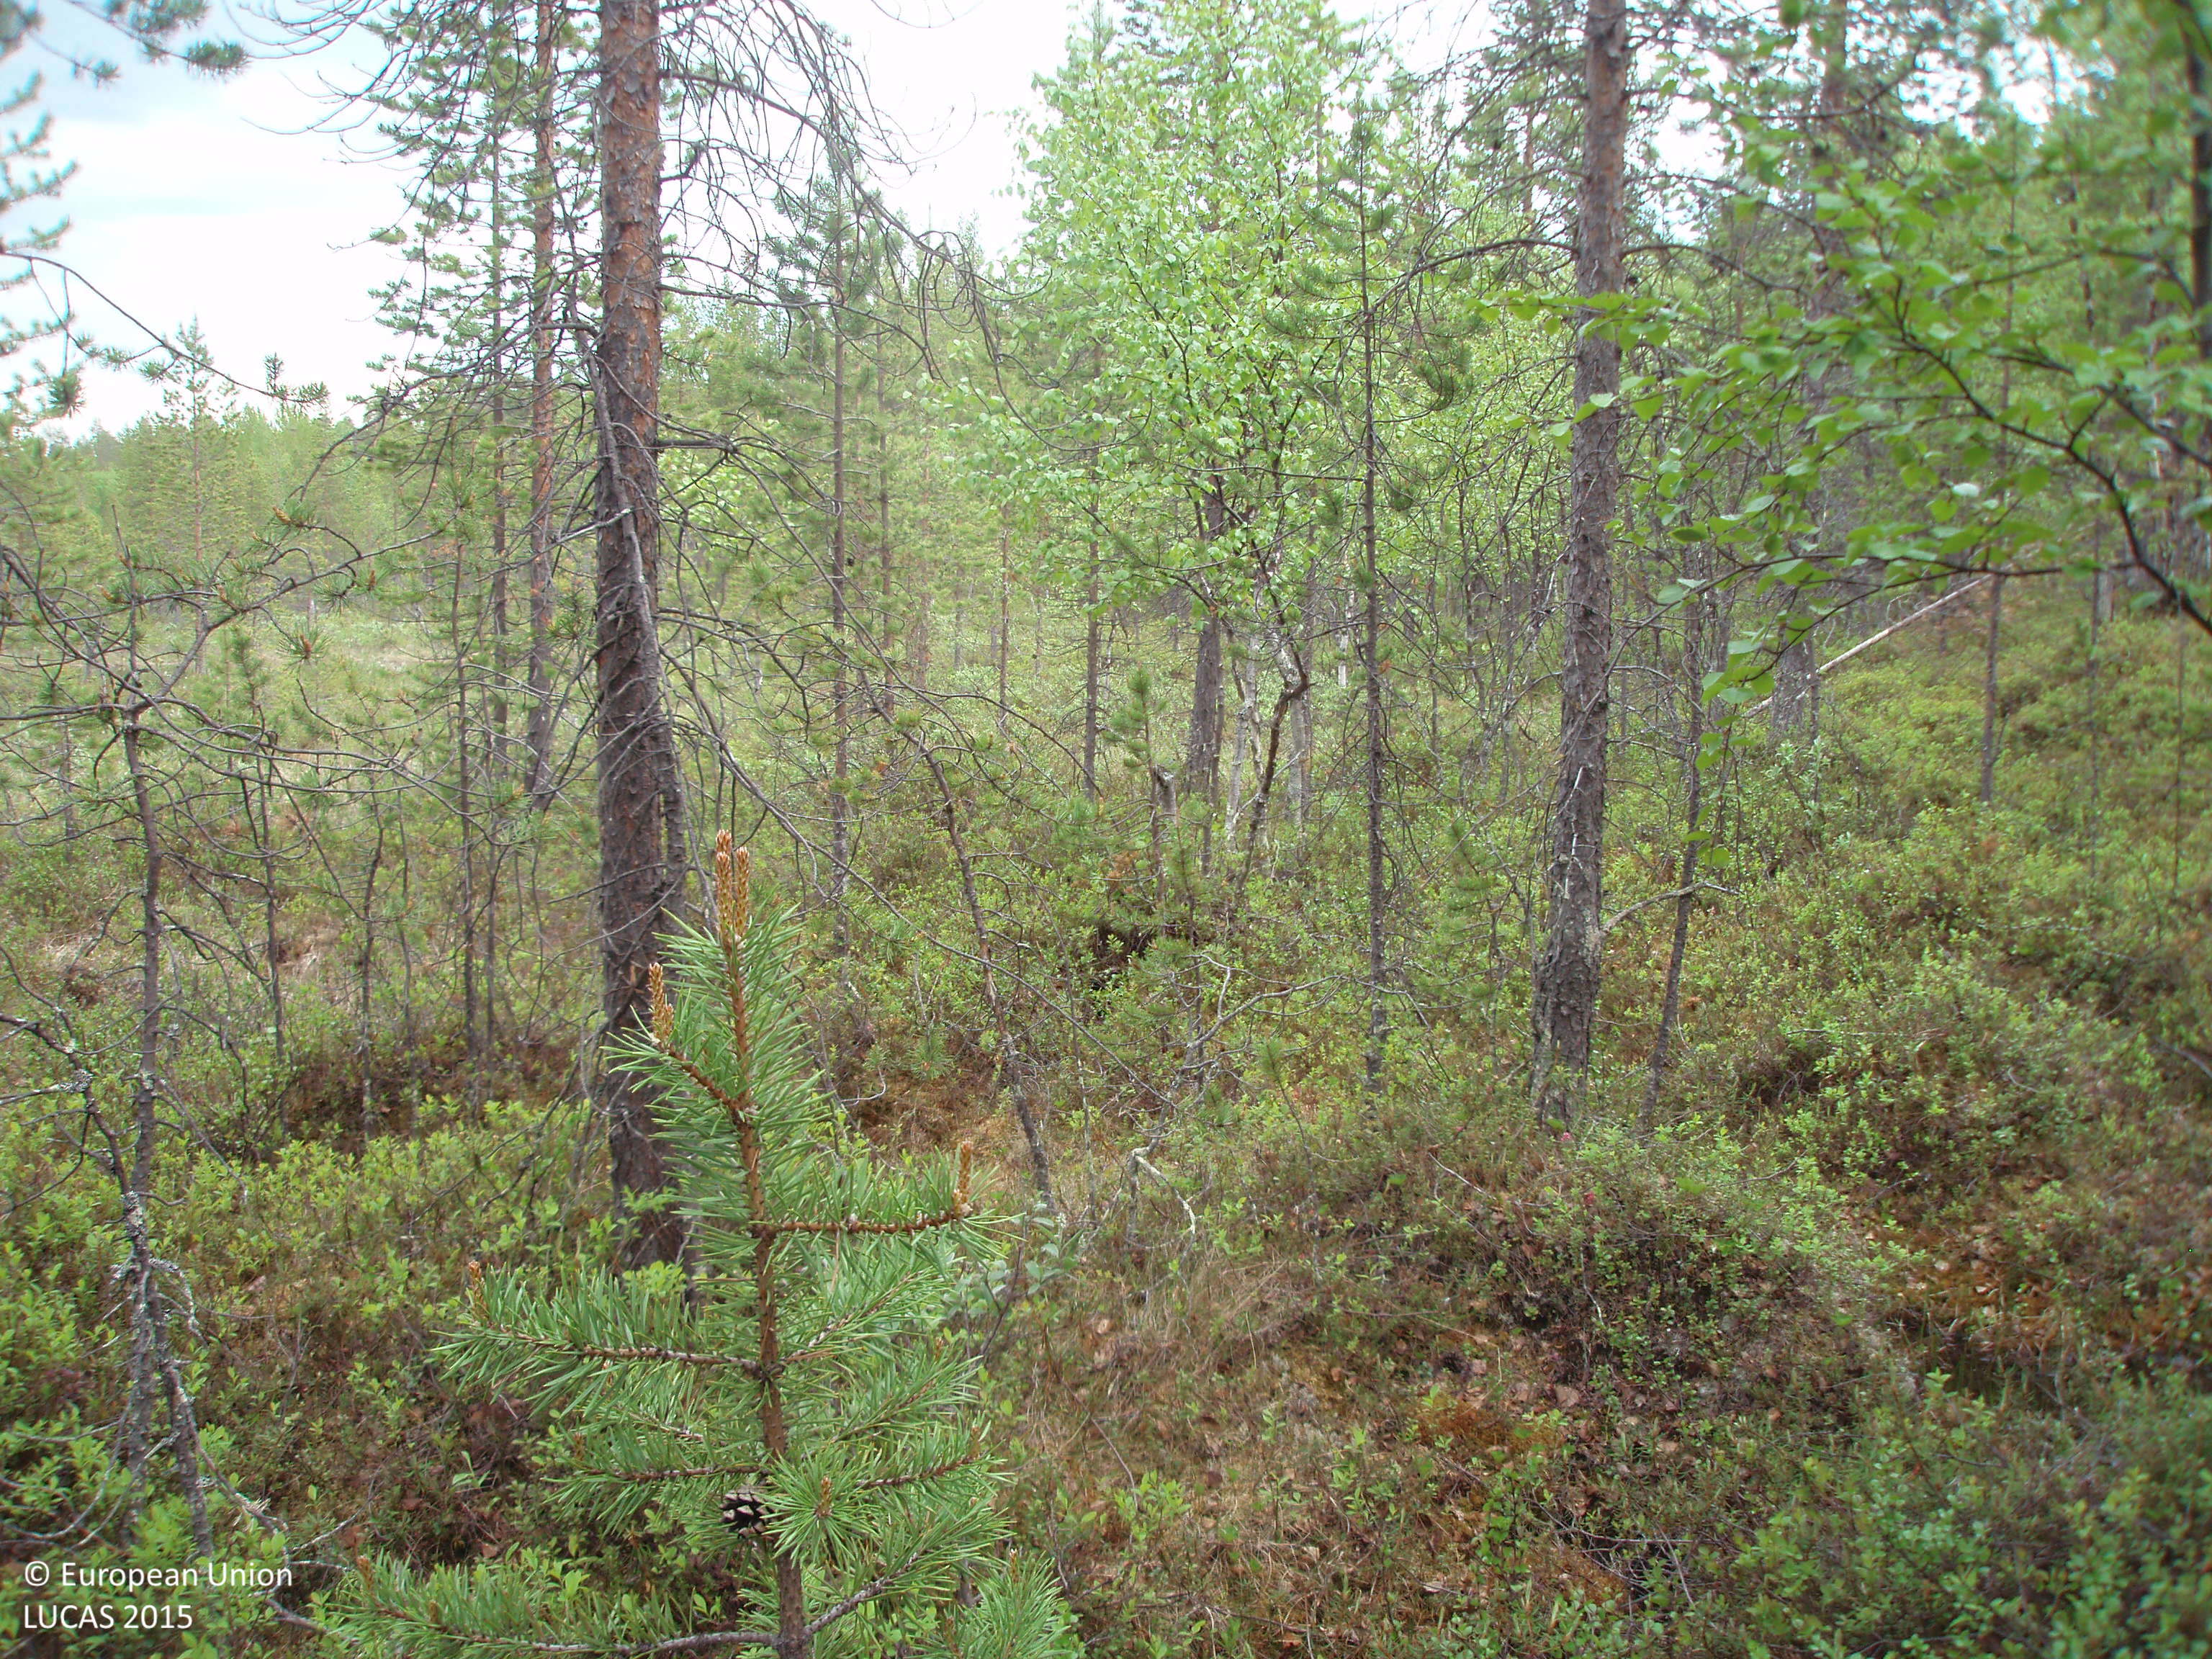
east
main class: Woodland
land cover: Pine dominated mixed woodland
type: boreal forest
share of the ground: > 75 %
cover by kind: coniferous forest trees 45 %, broadleaved forest trees 45 %, shrubs 5 %, unconsolidated bare surface 5 %
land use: Forestry
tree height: > 5 m
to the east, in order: Pine dominated mixed woodland; Inland fresh water bodies; Shrubland with sparse tree cover; Pine dominated coniferous woodland; Pine dominated mixed woodland; Inland fresh water bodies; Rocks and stones; Pine dominated mixed woodland
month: June
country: FI
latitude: 68.7833
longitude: 28.1435
